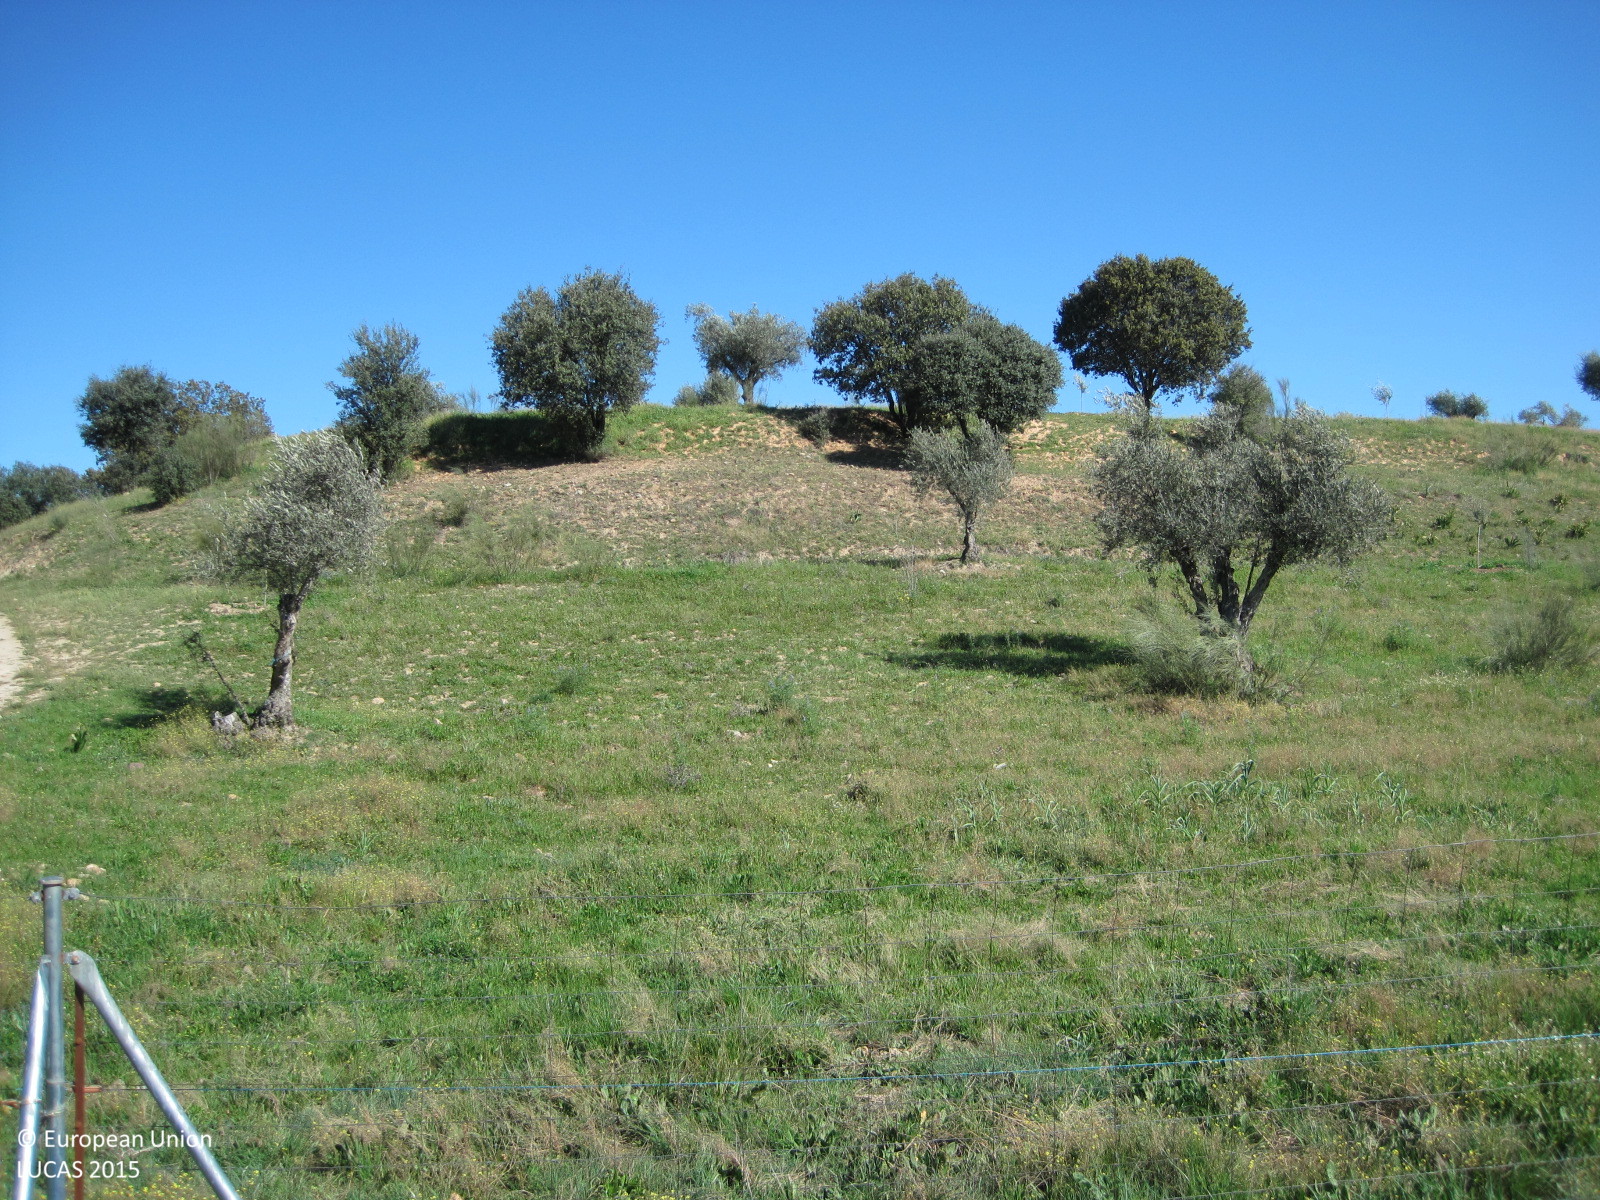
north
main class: Woodland
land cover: Broadleaved woodland
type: thermophilous deciduous forest
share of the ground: > 75 %
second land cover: Grassland without tree/shrub cover
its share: > 75 %
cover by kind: broadleaved forest trees 70 %, herbaceous plants 30 %
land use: Forestry
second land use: Agriculture (excluding fallow land and kitchen gardens)
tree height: > 5 m
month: April
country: ES
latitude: 39.9943
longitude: -4.7220
